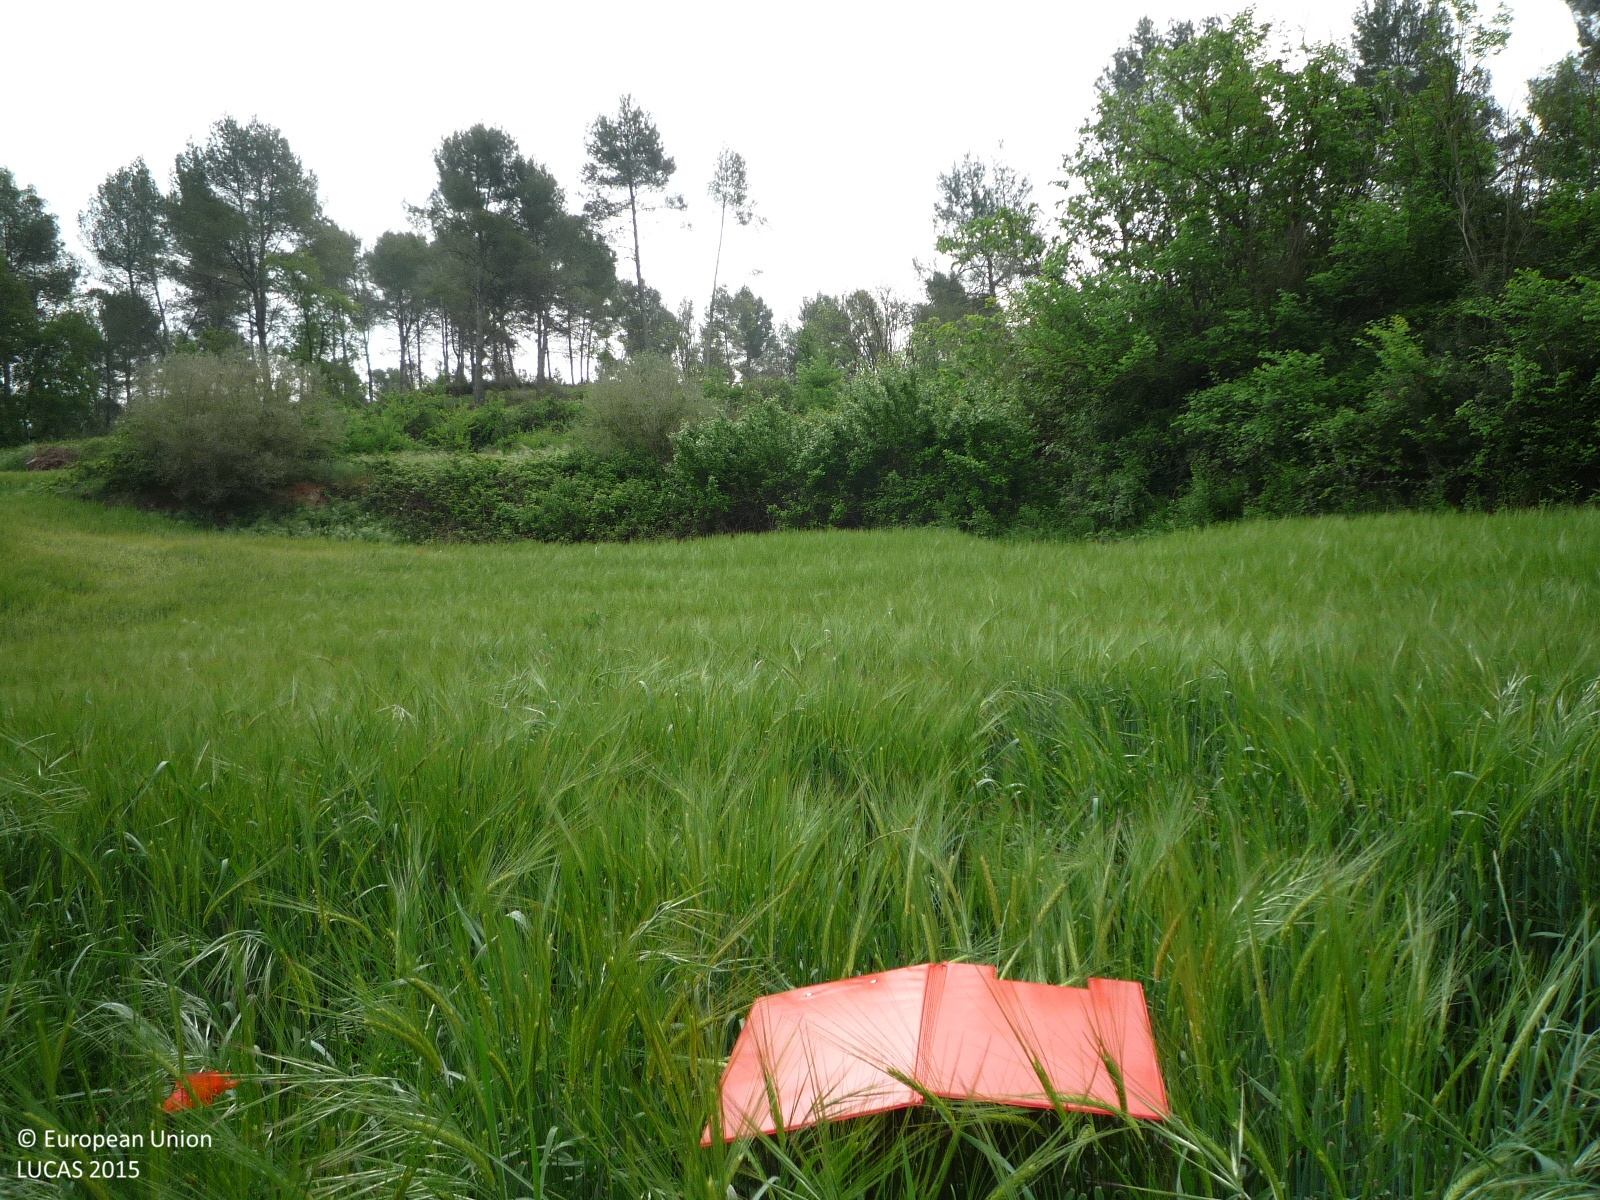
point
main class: Cropland
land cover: Barley
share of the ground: > 75 %
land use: Agriculture (excluding fallow land and kitchen gardens)
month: April
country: ES
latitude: 41.6190
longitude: 1.6504
